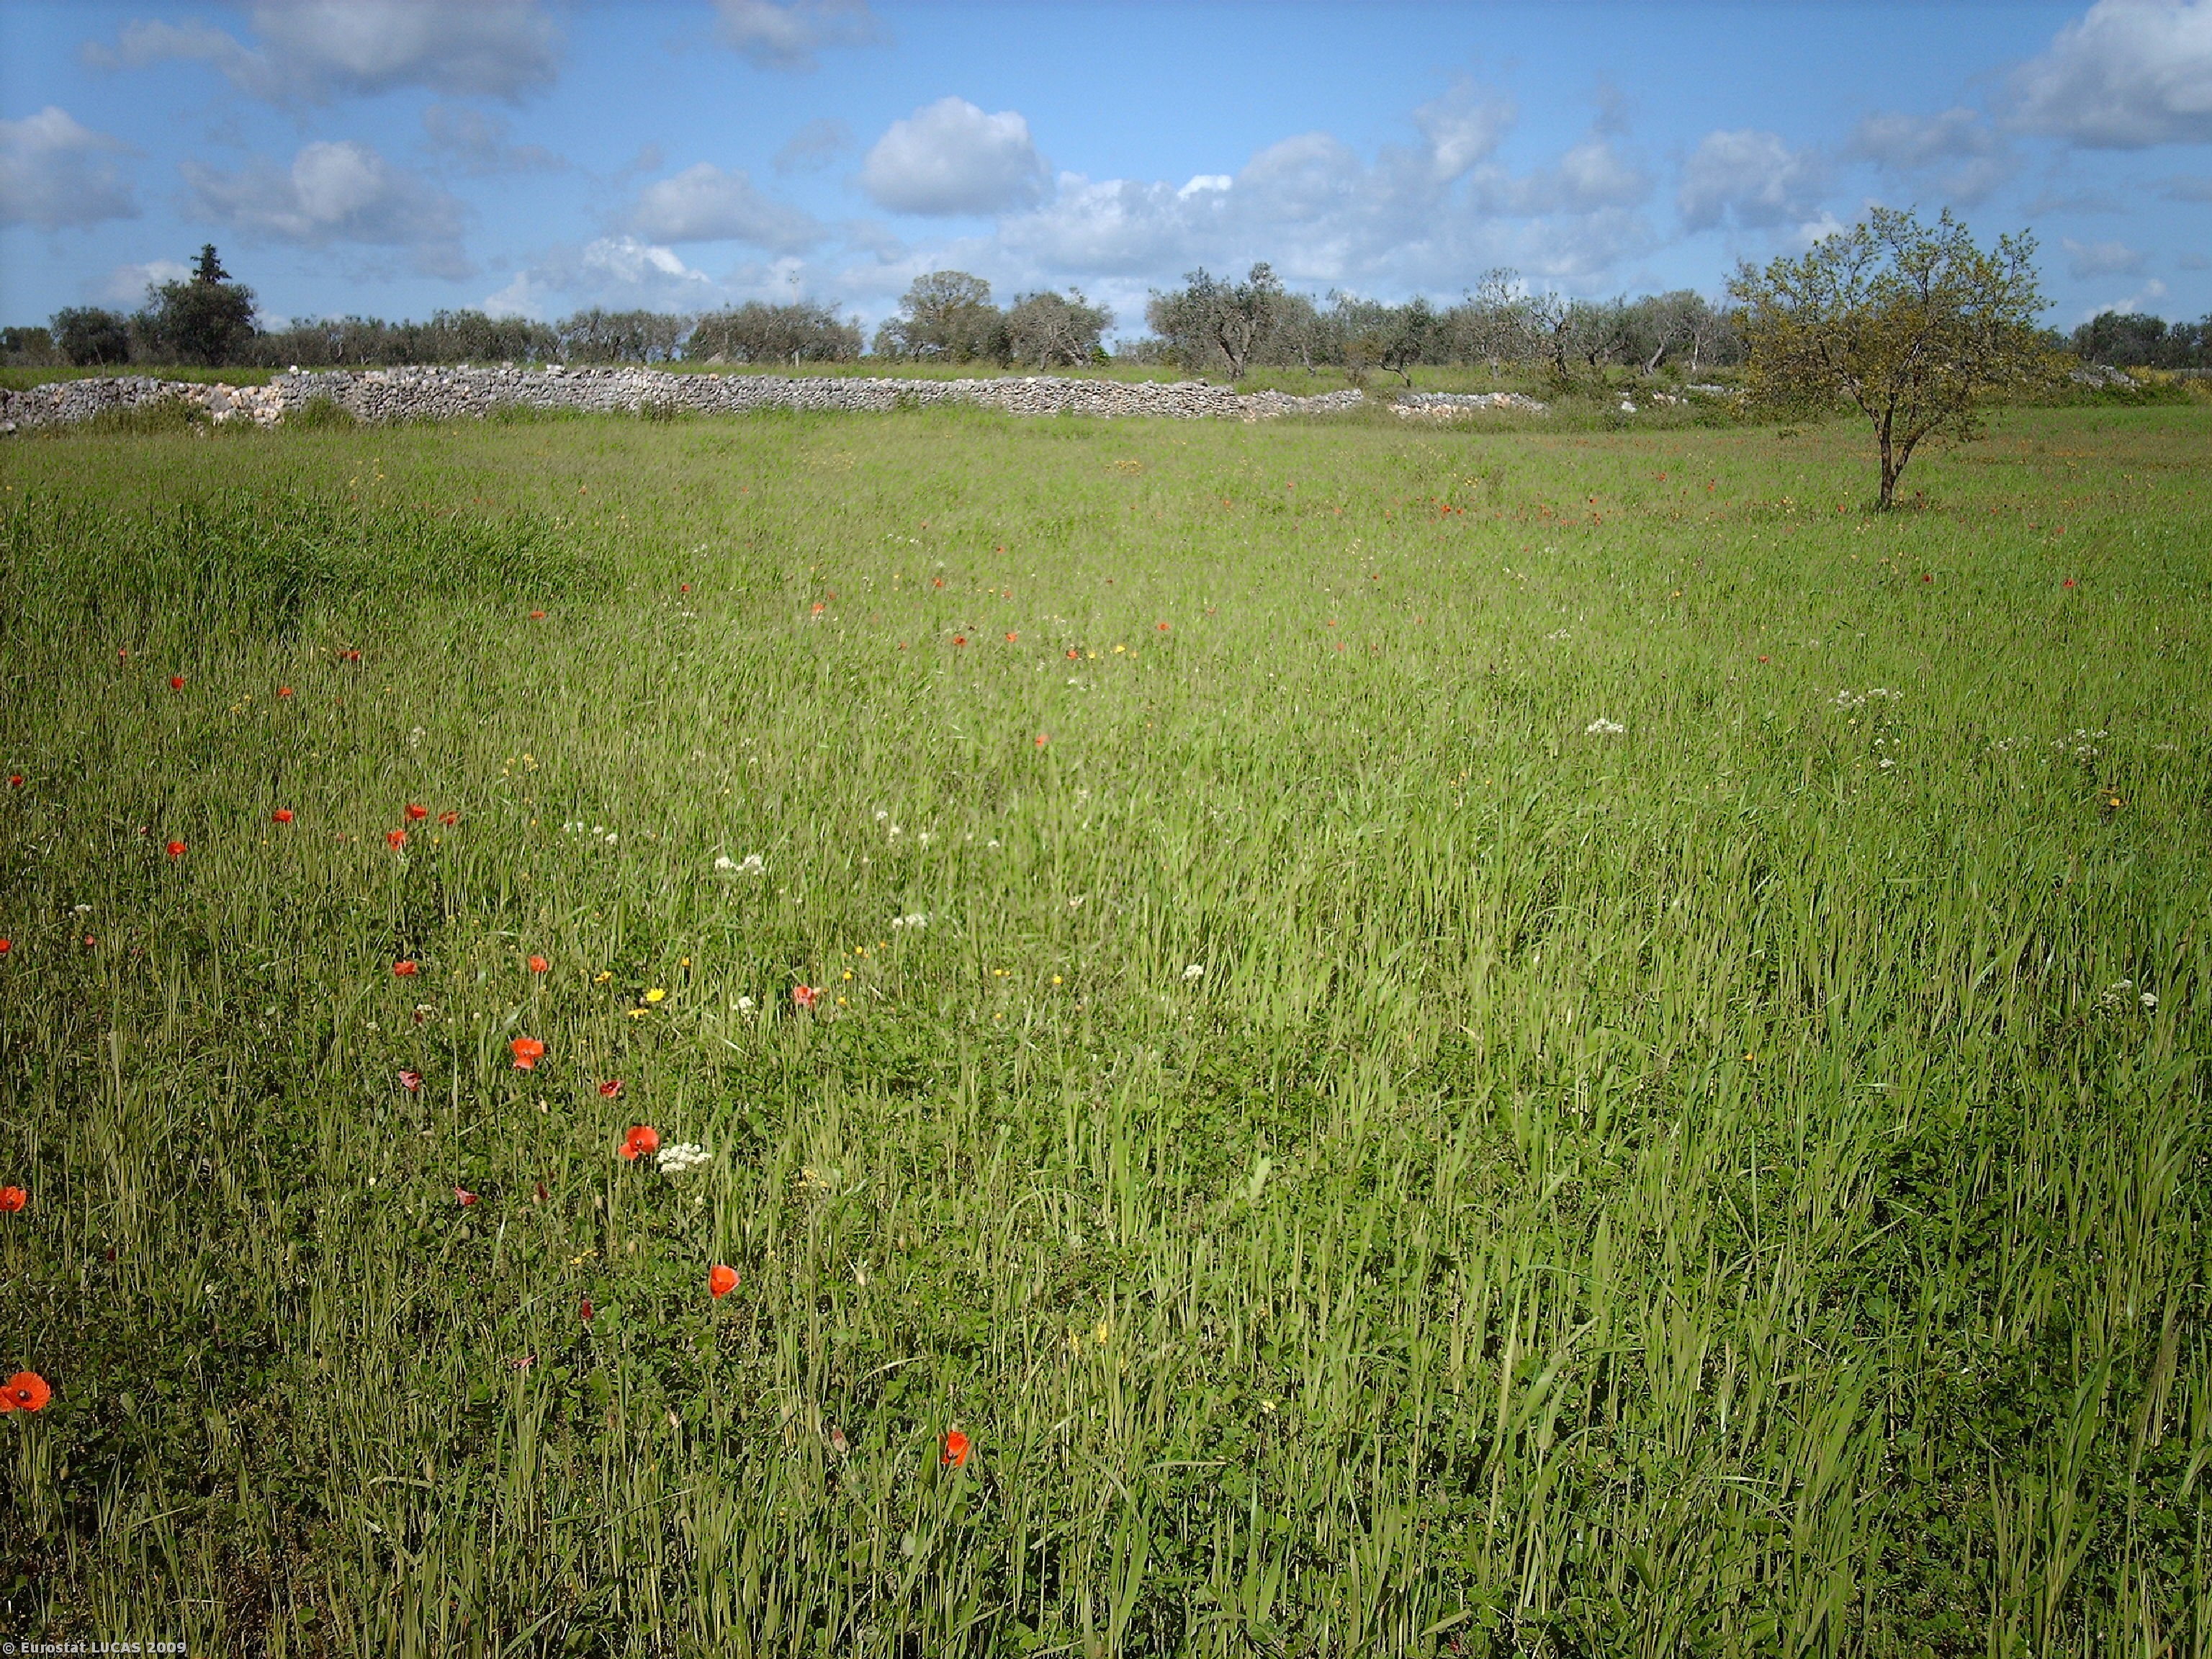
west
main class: Cropland
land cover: Mixed cereals for fodder
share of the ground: > 75 %
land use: Agriculture (excluding fallow land and kitchen gardens)
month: April
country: IT
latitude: 40.8252
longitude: 16.8667
